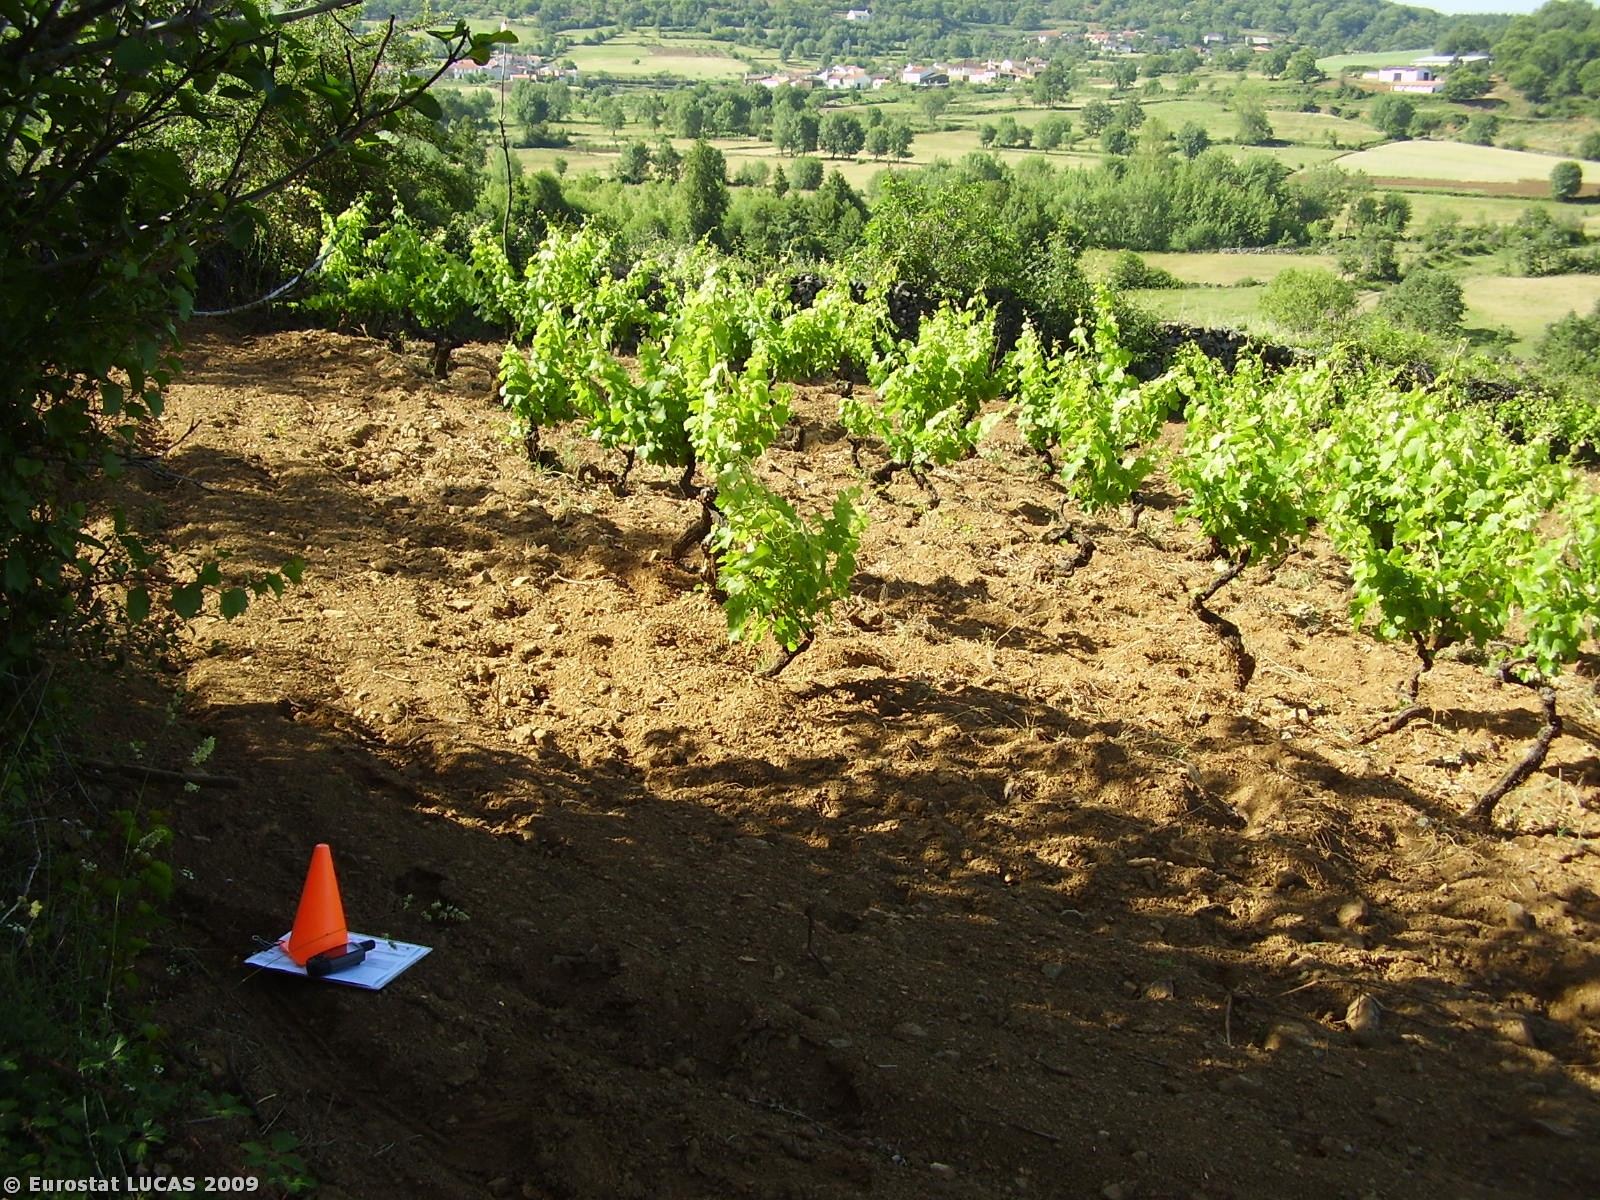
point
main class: Cropland
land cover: Vineyards
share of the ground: 25 - 50 %
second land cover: Bare land
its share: 10 - 25 %
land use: Agriculture (excluding fallow land and kitchen gardens)
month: June
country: PT
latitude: 41.8015
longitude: -6.9555
